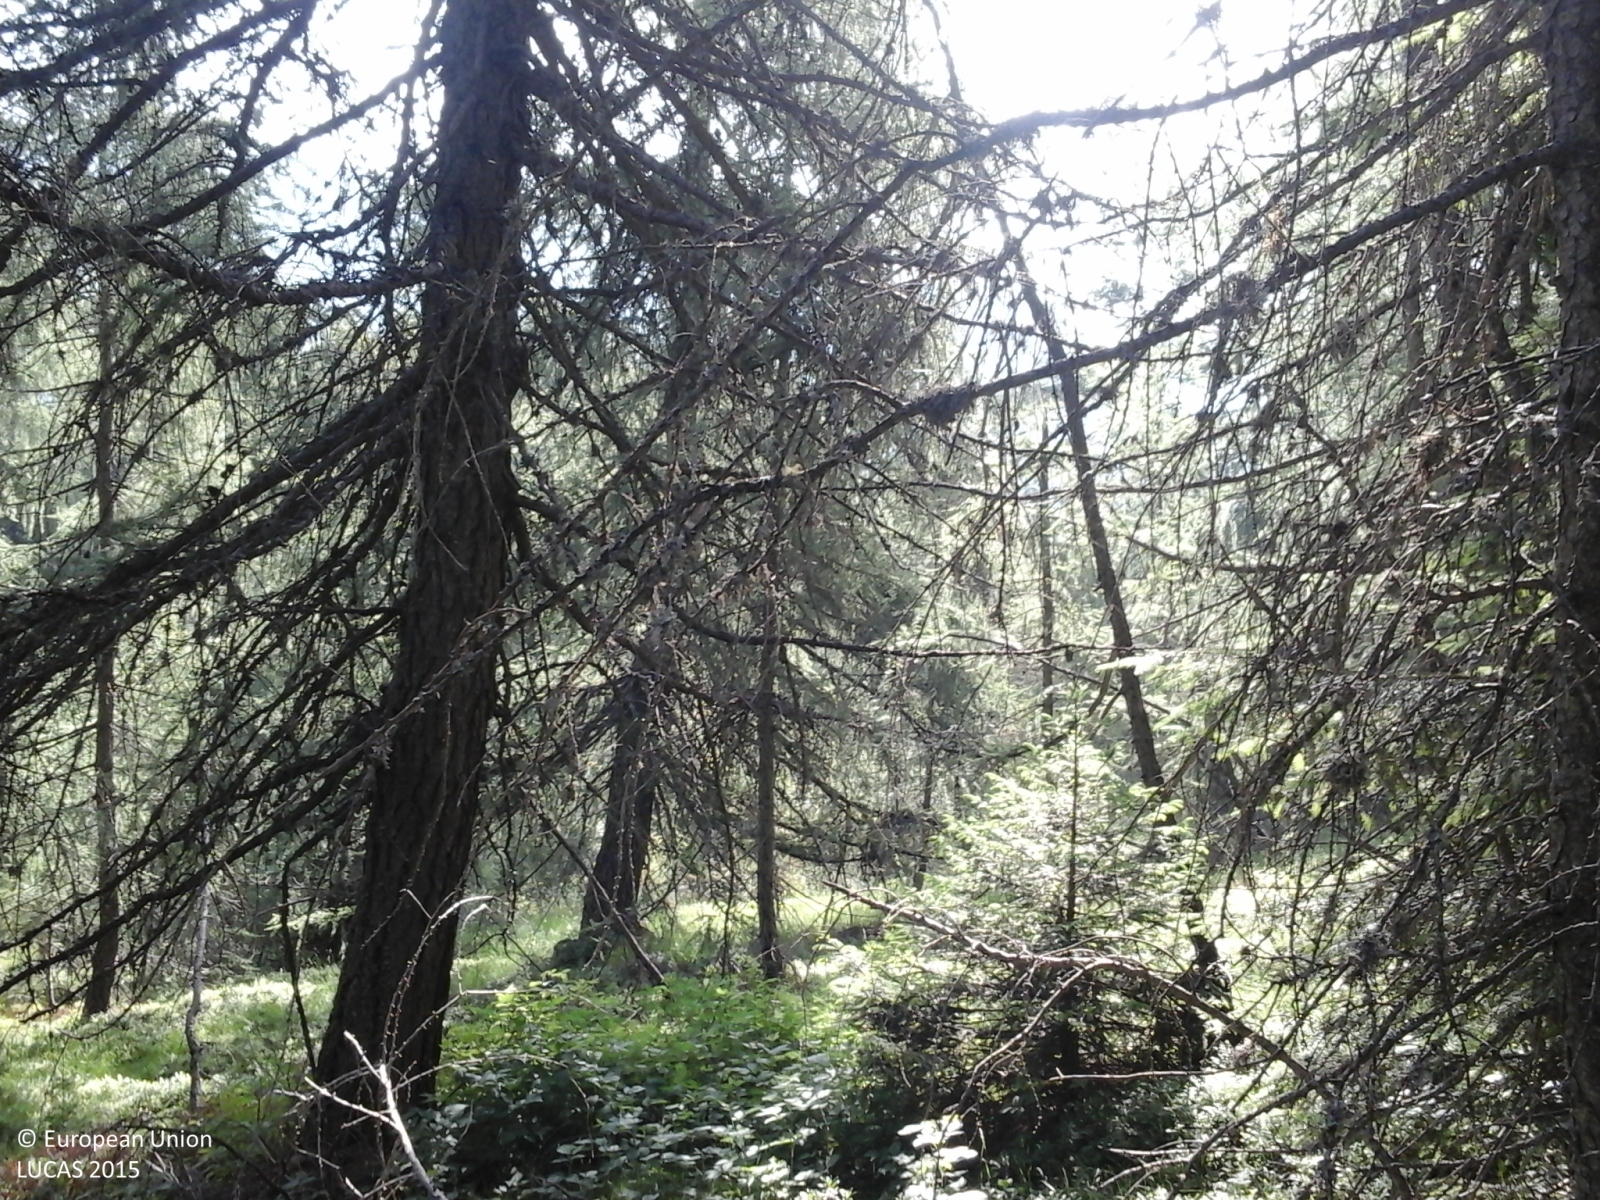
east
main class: Woodland
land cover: Spruce dominated coniferous woodland
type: alpine coniferous forest
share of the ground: > 75 %
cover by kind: coniferous forest trees 100 %
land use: Agriculture (excluding fallow land and kitchen gardens)
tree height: > 5 m
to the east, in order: Spruce dominated coniferous woodland; Tracks; Spruce dominated coniferous woodland; Tracks; Spruce dominated coniferous woodland
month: July
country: IT
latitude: 46.1888
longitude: 10.2458
